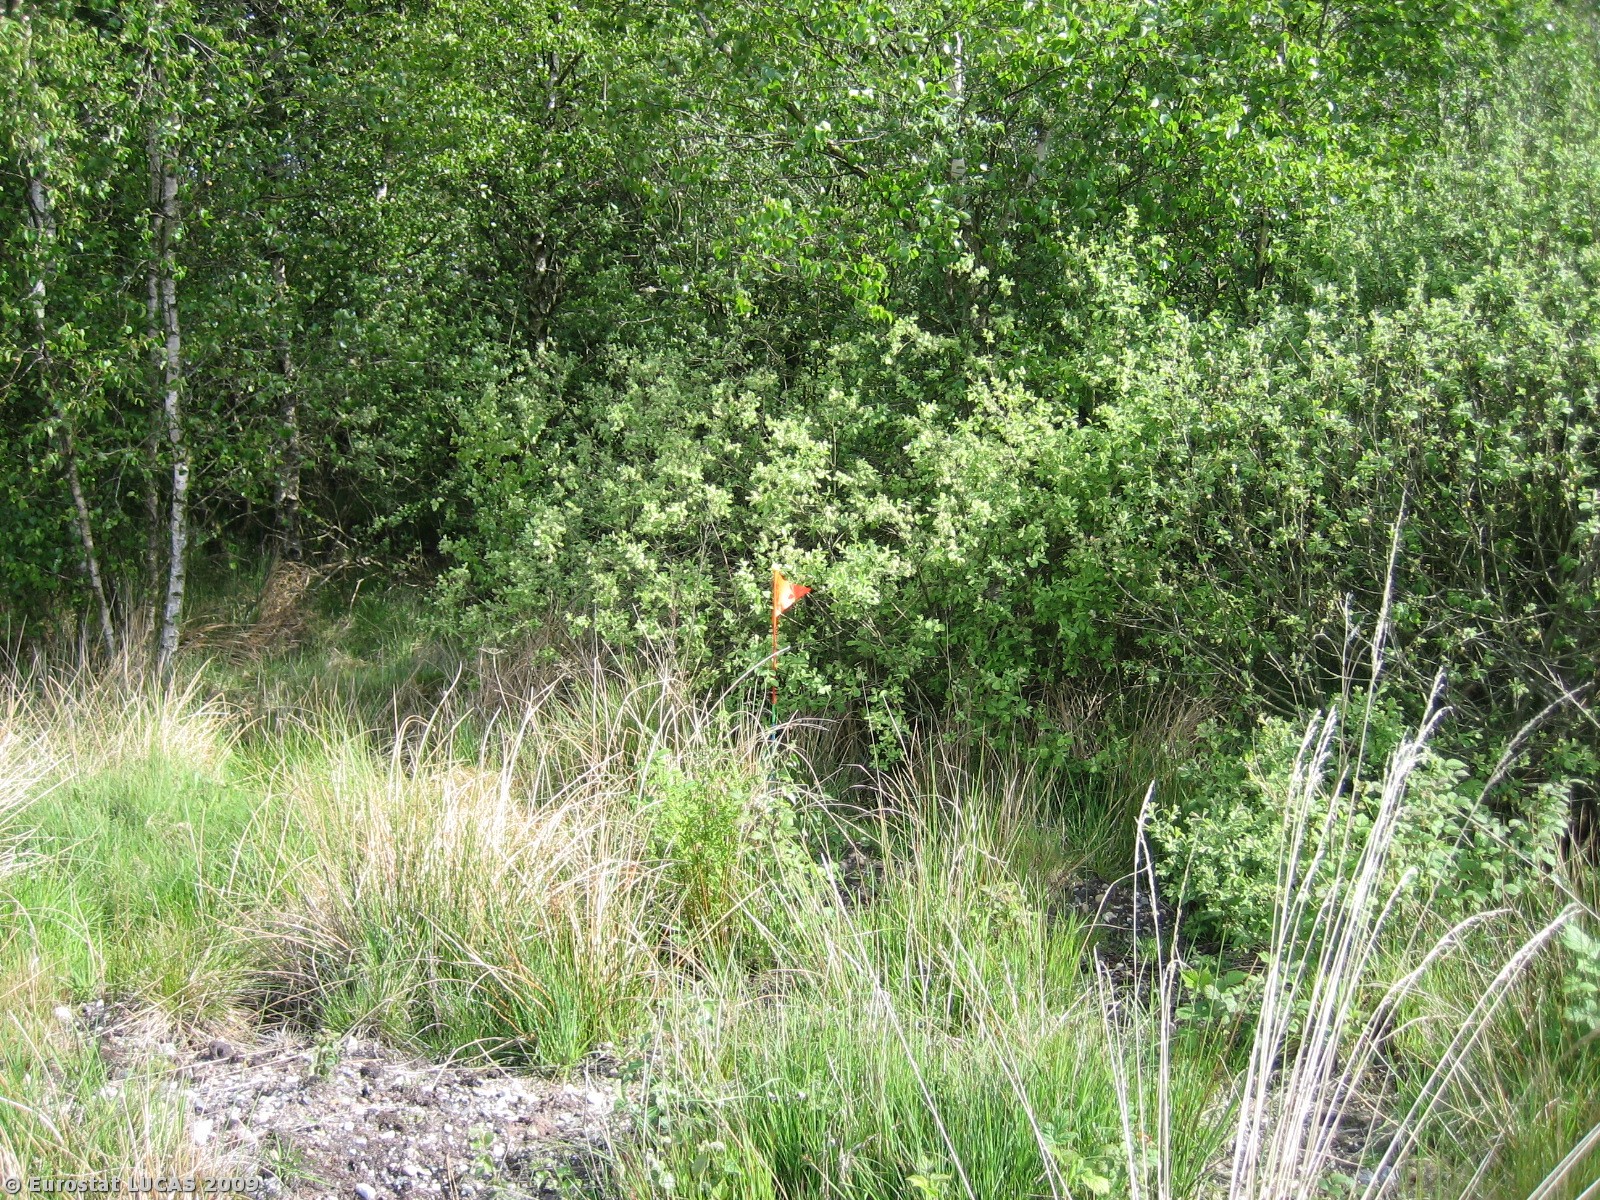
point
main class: Shrubland
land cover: Shrubland with sparse tree cover
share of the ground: > 75 %
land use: Unused
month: May
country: DK
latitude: 56.0928
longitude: 8.8601
